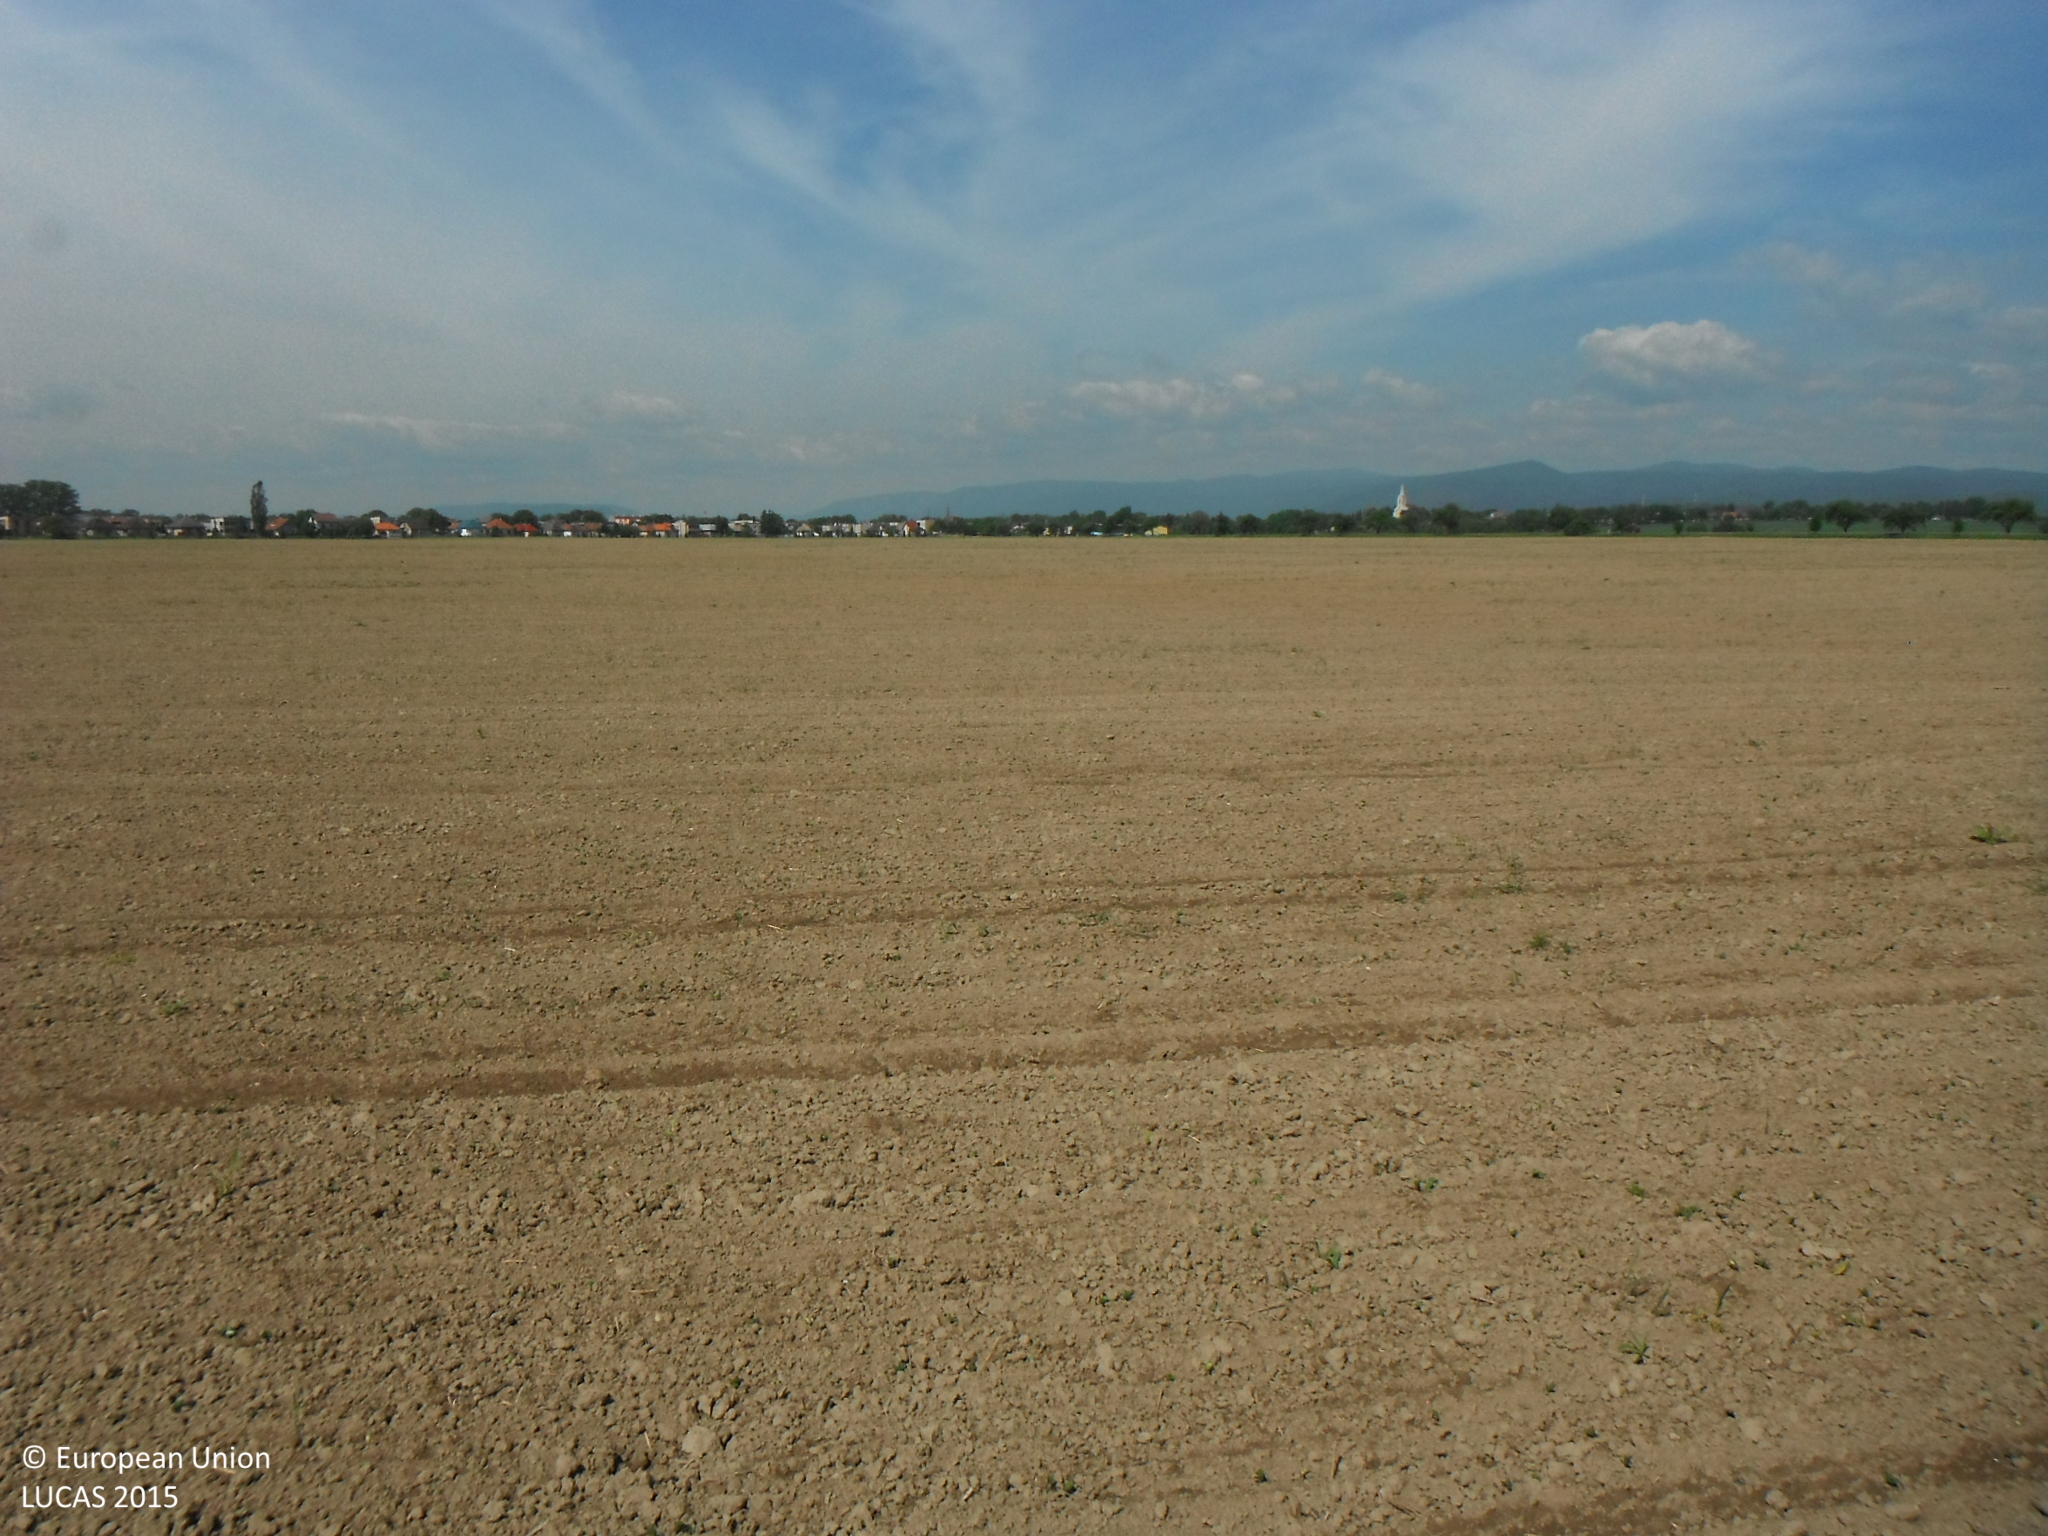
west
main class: Cropland
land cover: Soya
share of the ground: < 10 %
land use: Agriculture (excluding fallow land and kitchen gardens)
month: May
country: SK
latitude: 48.5936
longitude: 21.0375
